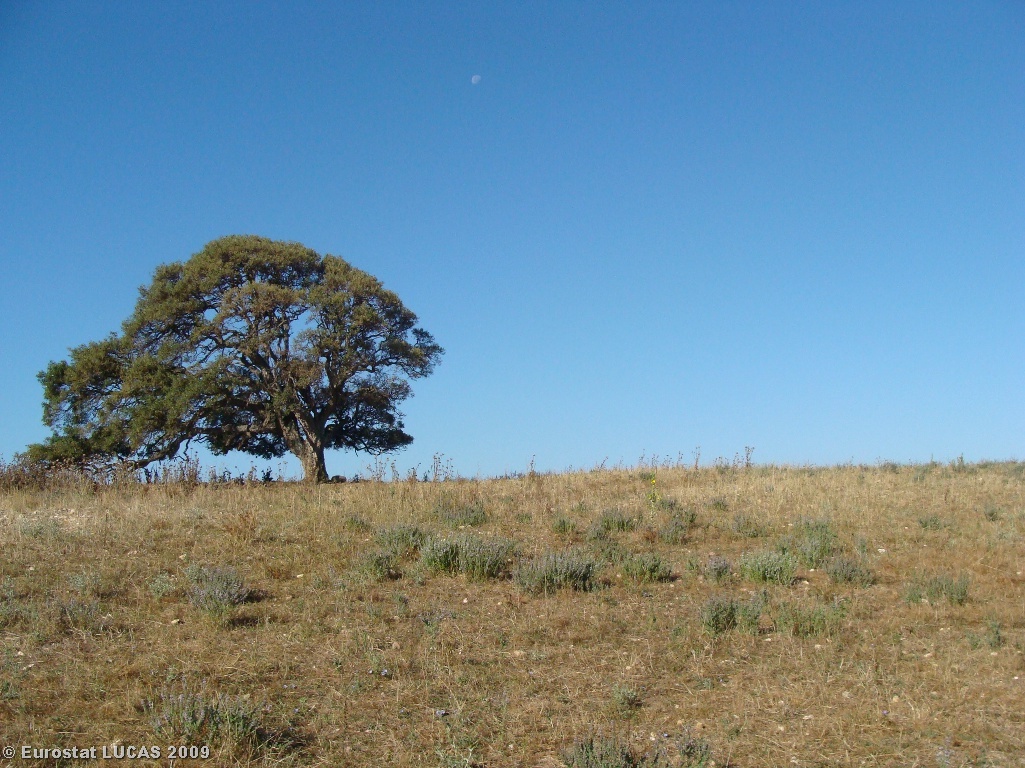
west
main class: Grassland
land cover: Grassland without tree/shrub cover
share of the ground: > 75 %
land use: Agriculture (excluding fallow land and kitchen gardens)
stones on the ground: < 10 %
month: June
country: IT
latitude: 40.7070
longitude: 8.4098
